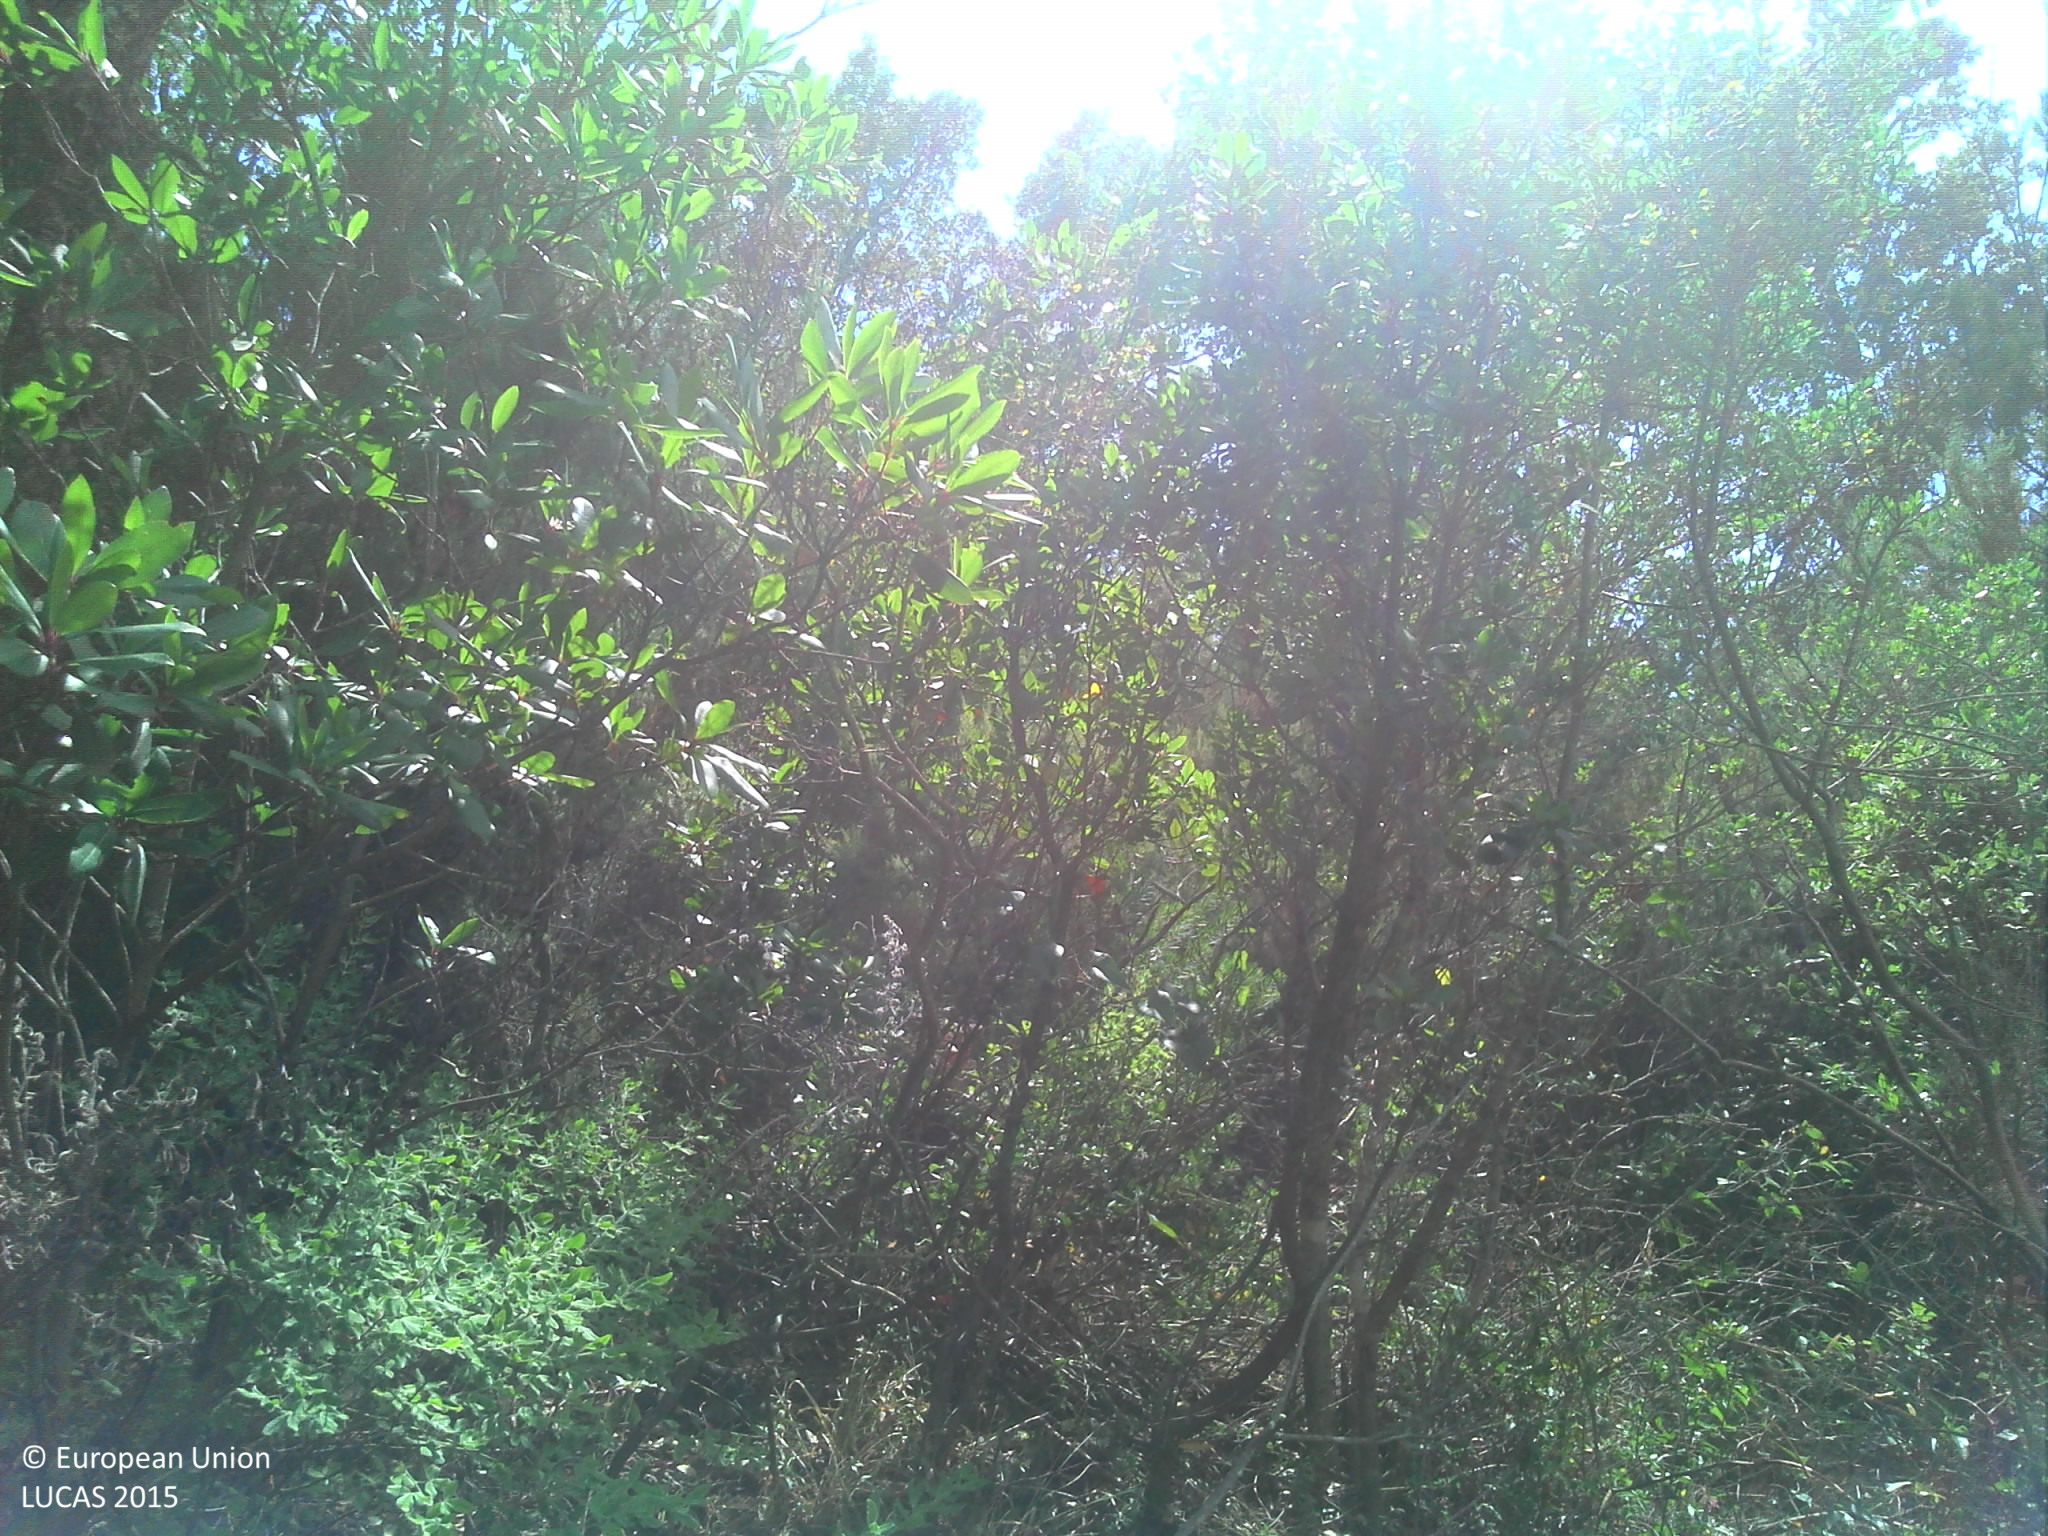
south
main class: Woodland
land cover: Pine dominated mixed woodland
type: coniferous forest of the mediterranean region
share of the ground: > 75 %
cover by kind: coniferous forest trees 50 %, broadleaved forest trees 25 %, shrubs 25 %
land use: Semi-natural and natural areas not in use
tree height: > 5 m
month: July
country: FR
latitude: 43.1866
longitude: 6.4043
